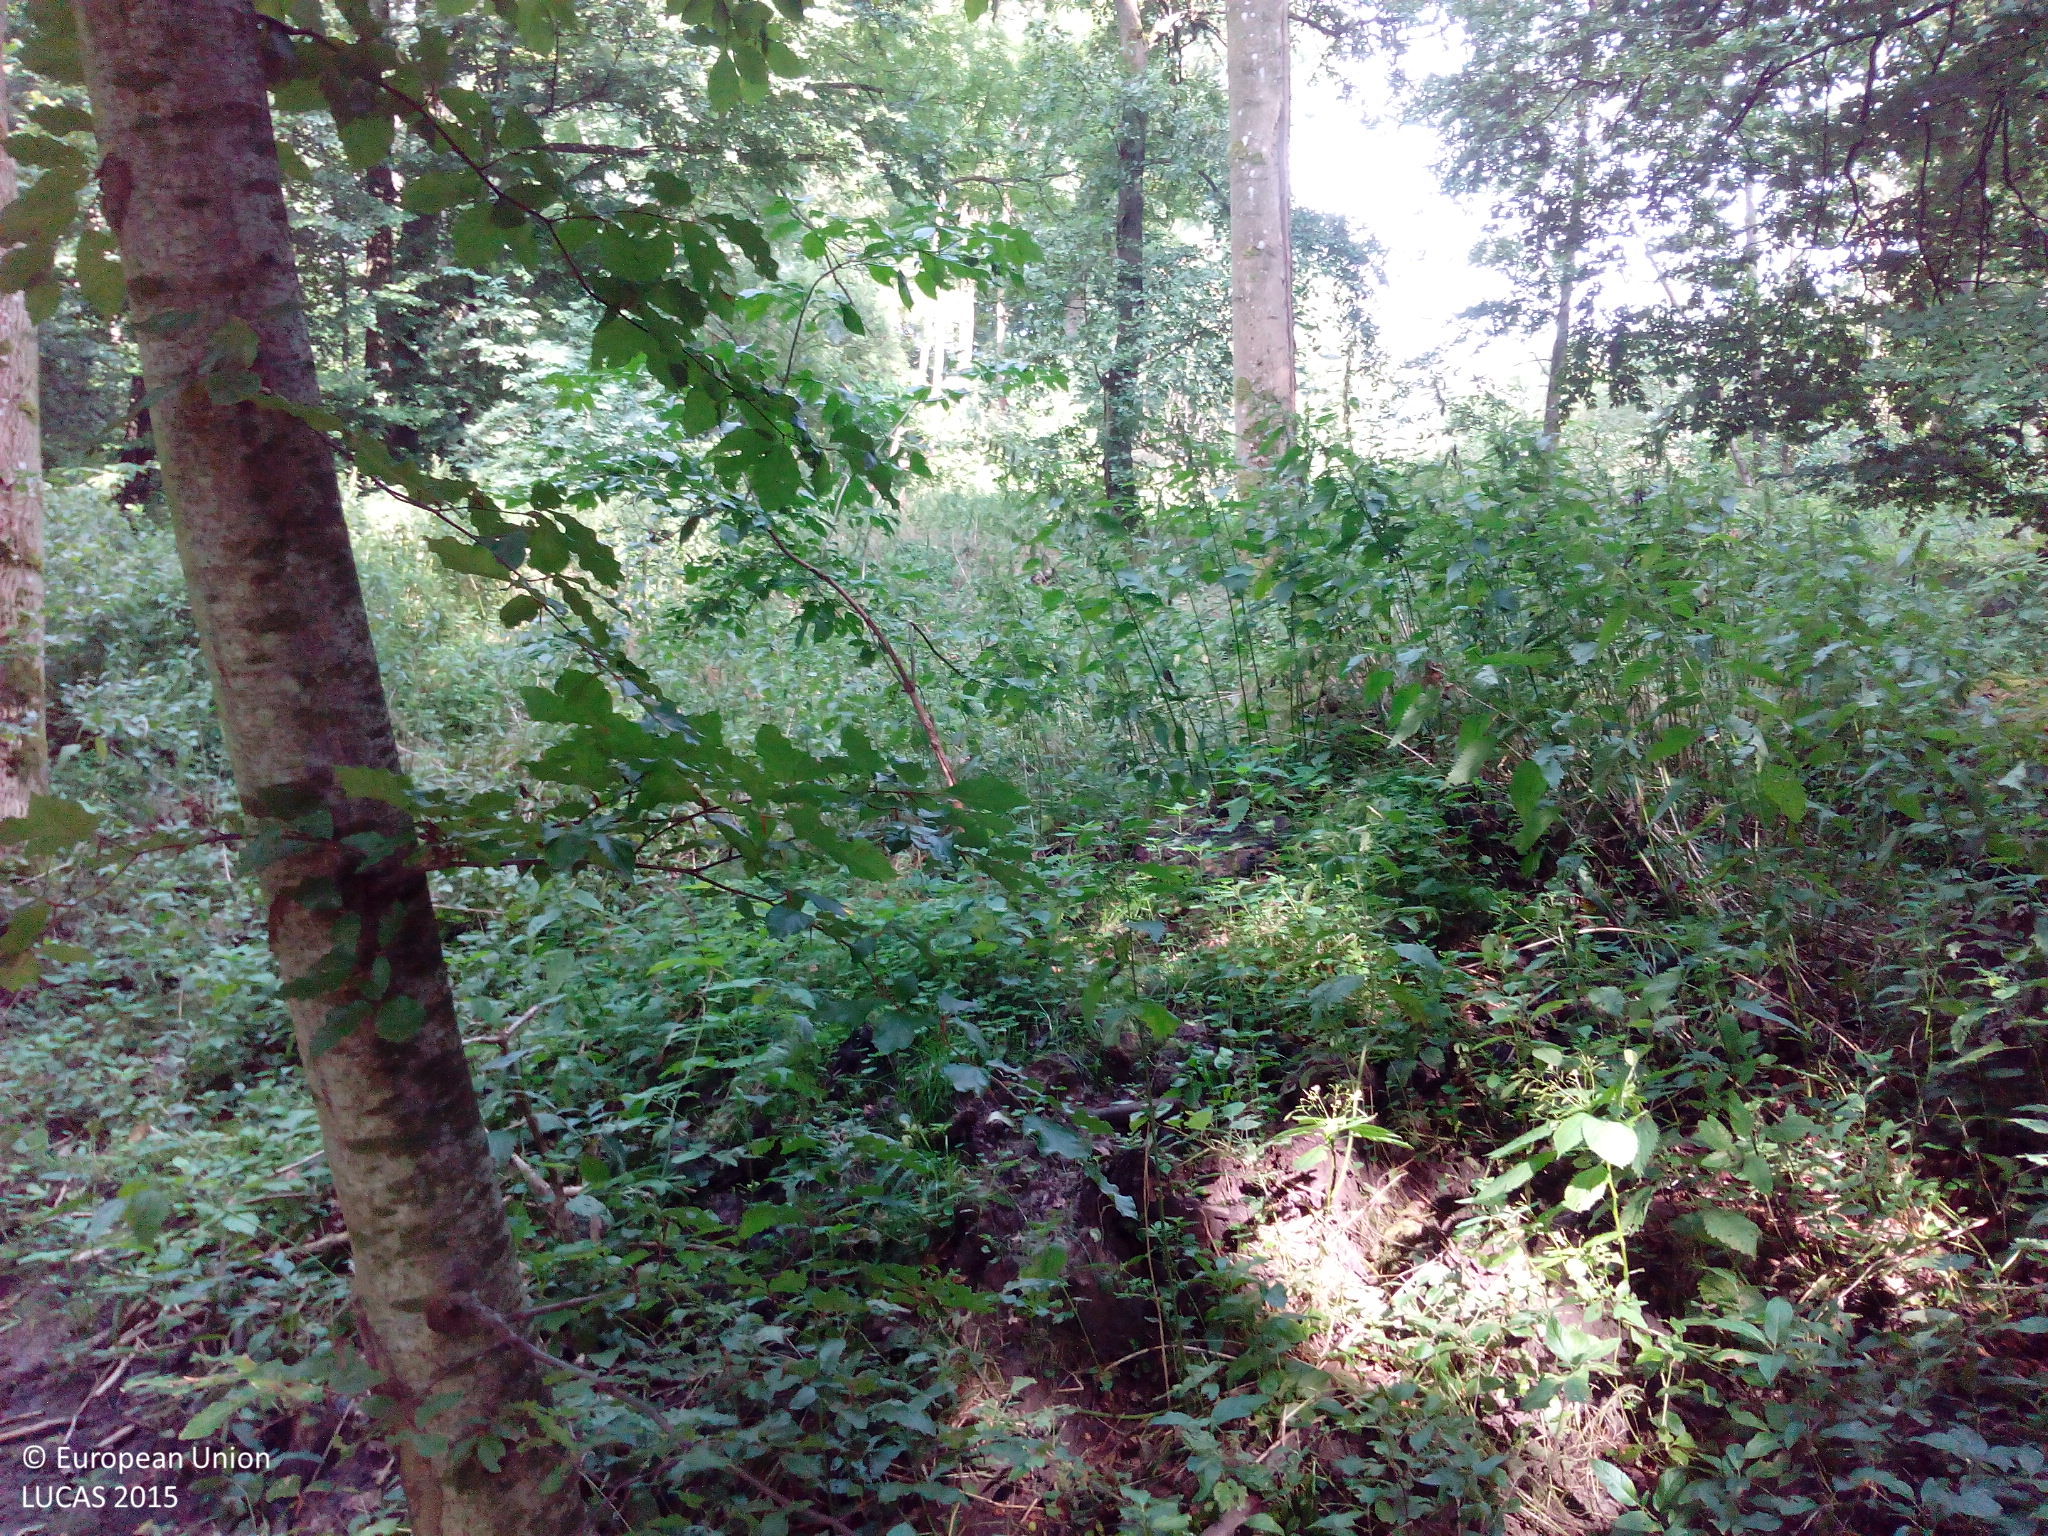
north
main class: Woodland
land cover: Broadleaved woodland
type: mesophytic deciduous forest
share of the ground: > 75 %
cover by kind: broadleaved forest trees 90 %, shrubs 5 %, herbaceous plants 5 %
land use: Forestry
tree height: > 5 m
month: August
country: DE
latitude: 54.2181
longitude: 12.6521
